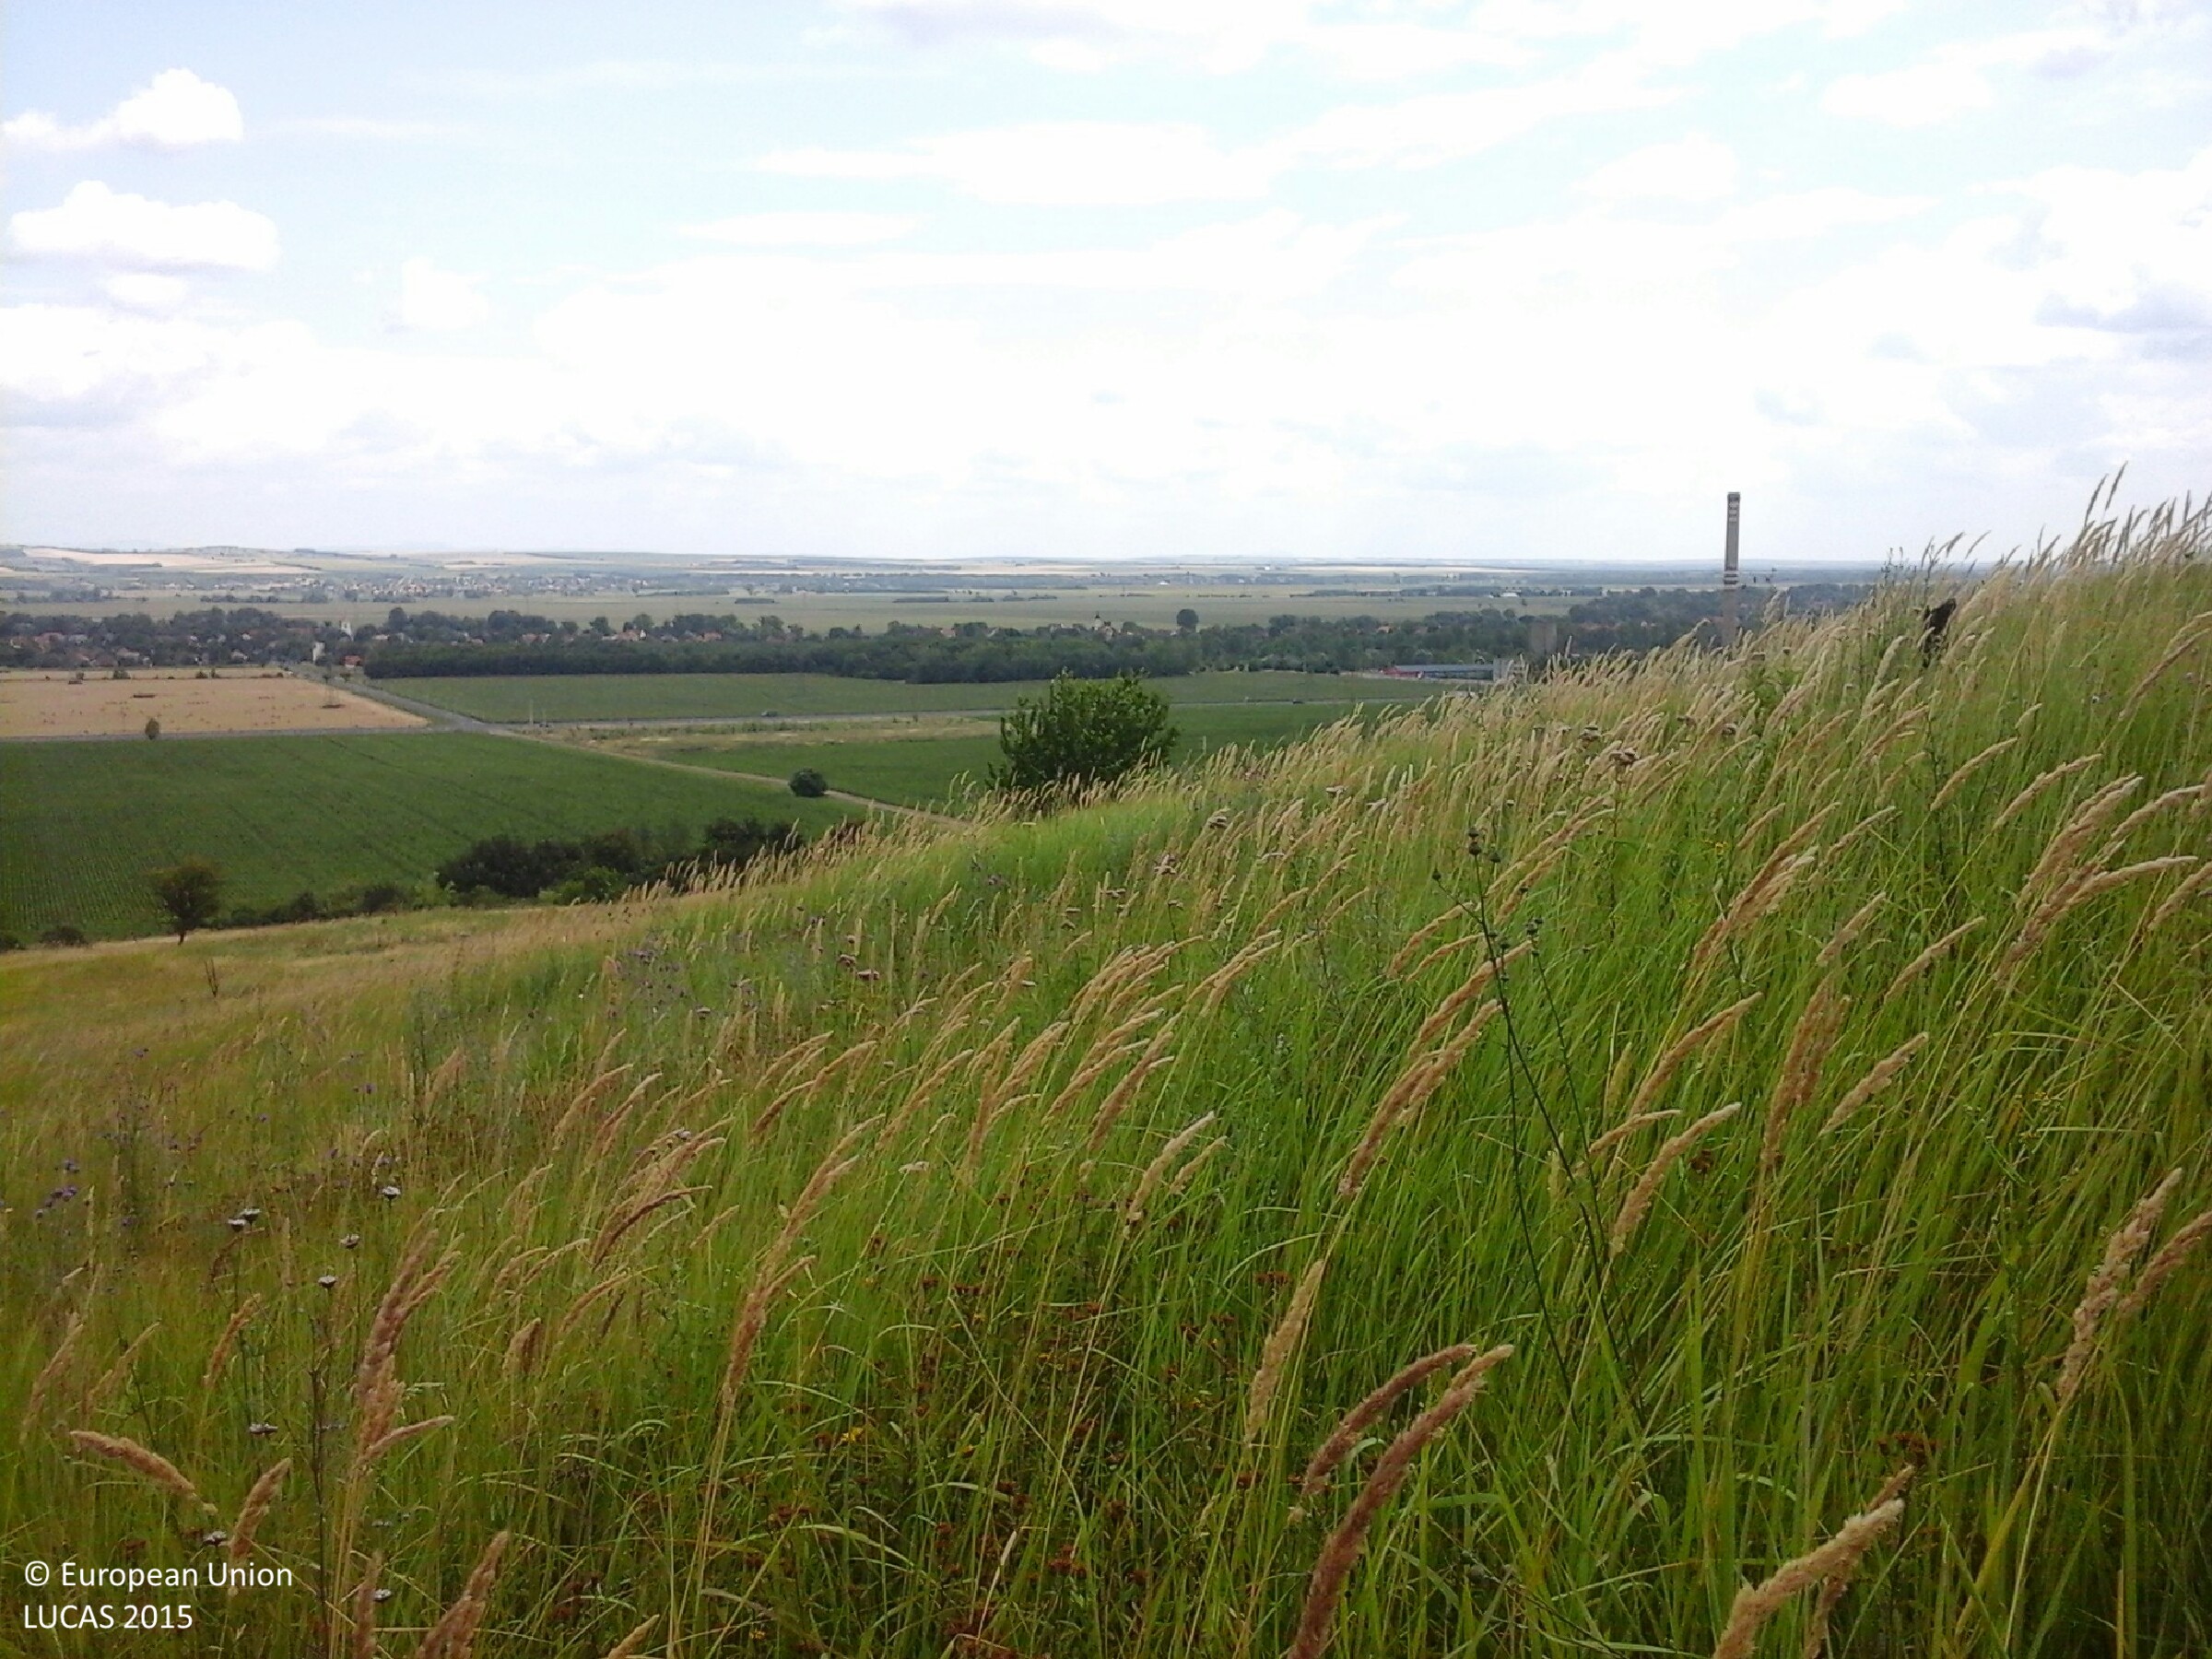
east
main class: Grassland
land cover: Grassland with sparse tree/shrub cover
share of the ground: > 75 %
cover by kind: herbaceous plants 85 %, shrubs 10 %, broadleaved forest trees 5 %
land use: Abandoned areas
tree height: < 5 m
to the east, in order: Grassland with sparse tree/shrub cover; Vineyards; Grassland with sparse tree/shrub cover
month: July
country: HU
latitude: 48.1679
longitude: 20.7532
